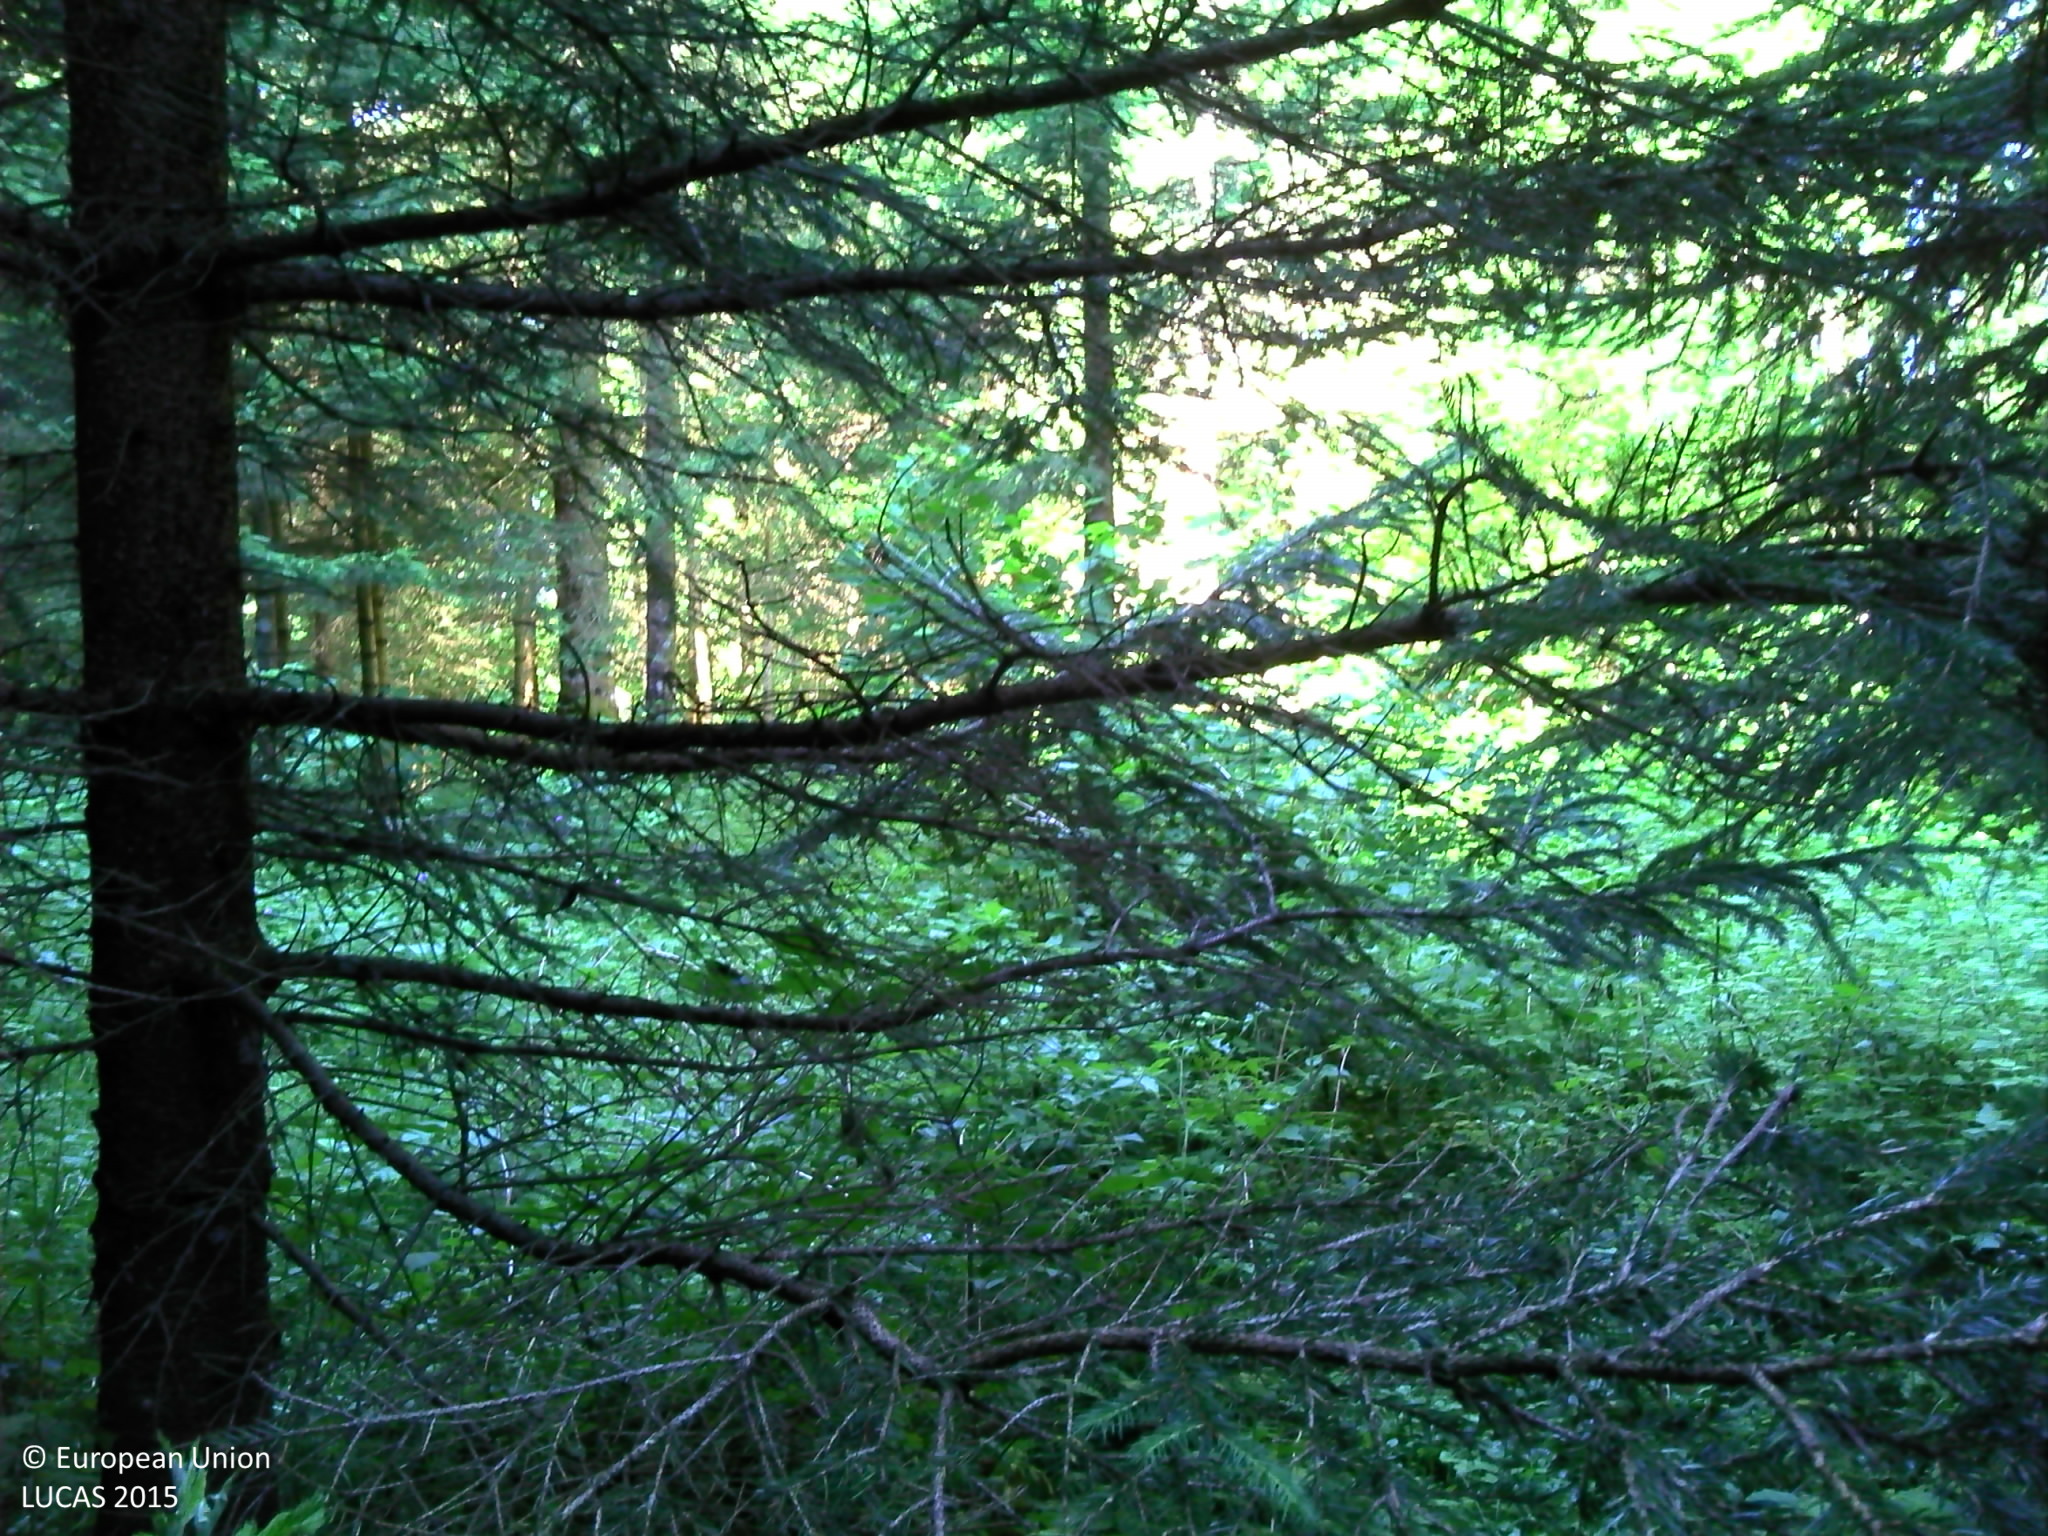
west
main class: Woodland
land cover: Spruce dominated coniferous woodland
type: alpine coniferous forest
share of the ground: > 75 %
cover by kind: coniferous forest trees 60 %, herbaceous plants 20 %, lichens and mosses 20 %
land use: Forestry
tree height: > 5 m
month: July
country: FR
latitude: 46.6397
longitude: 6.0705
